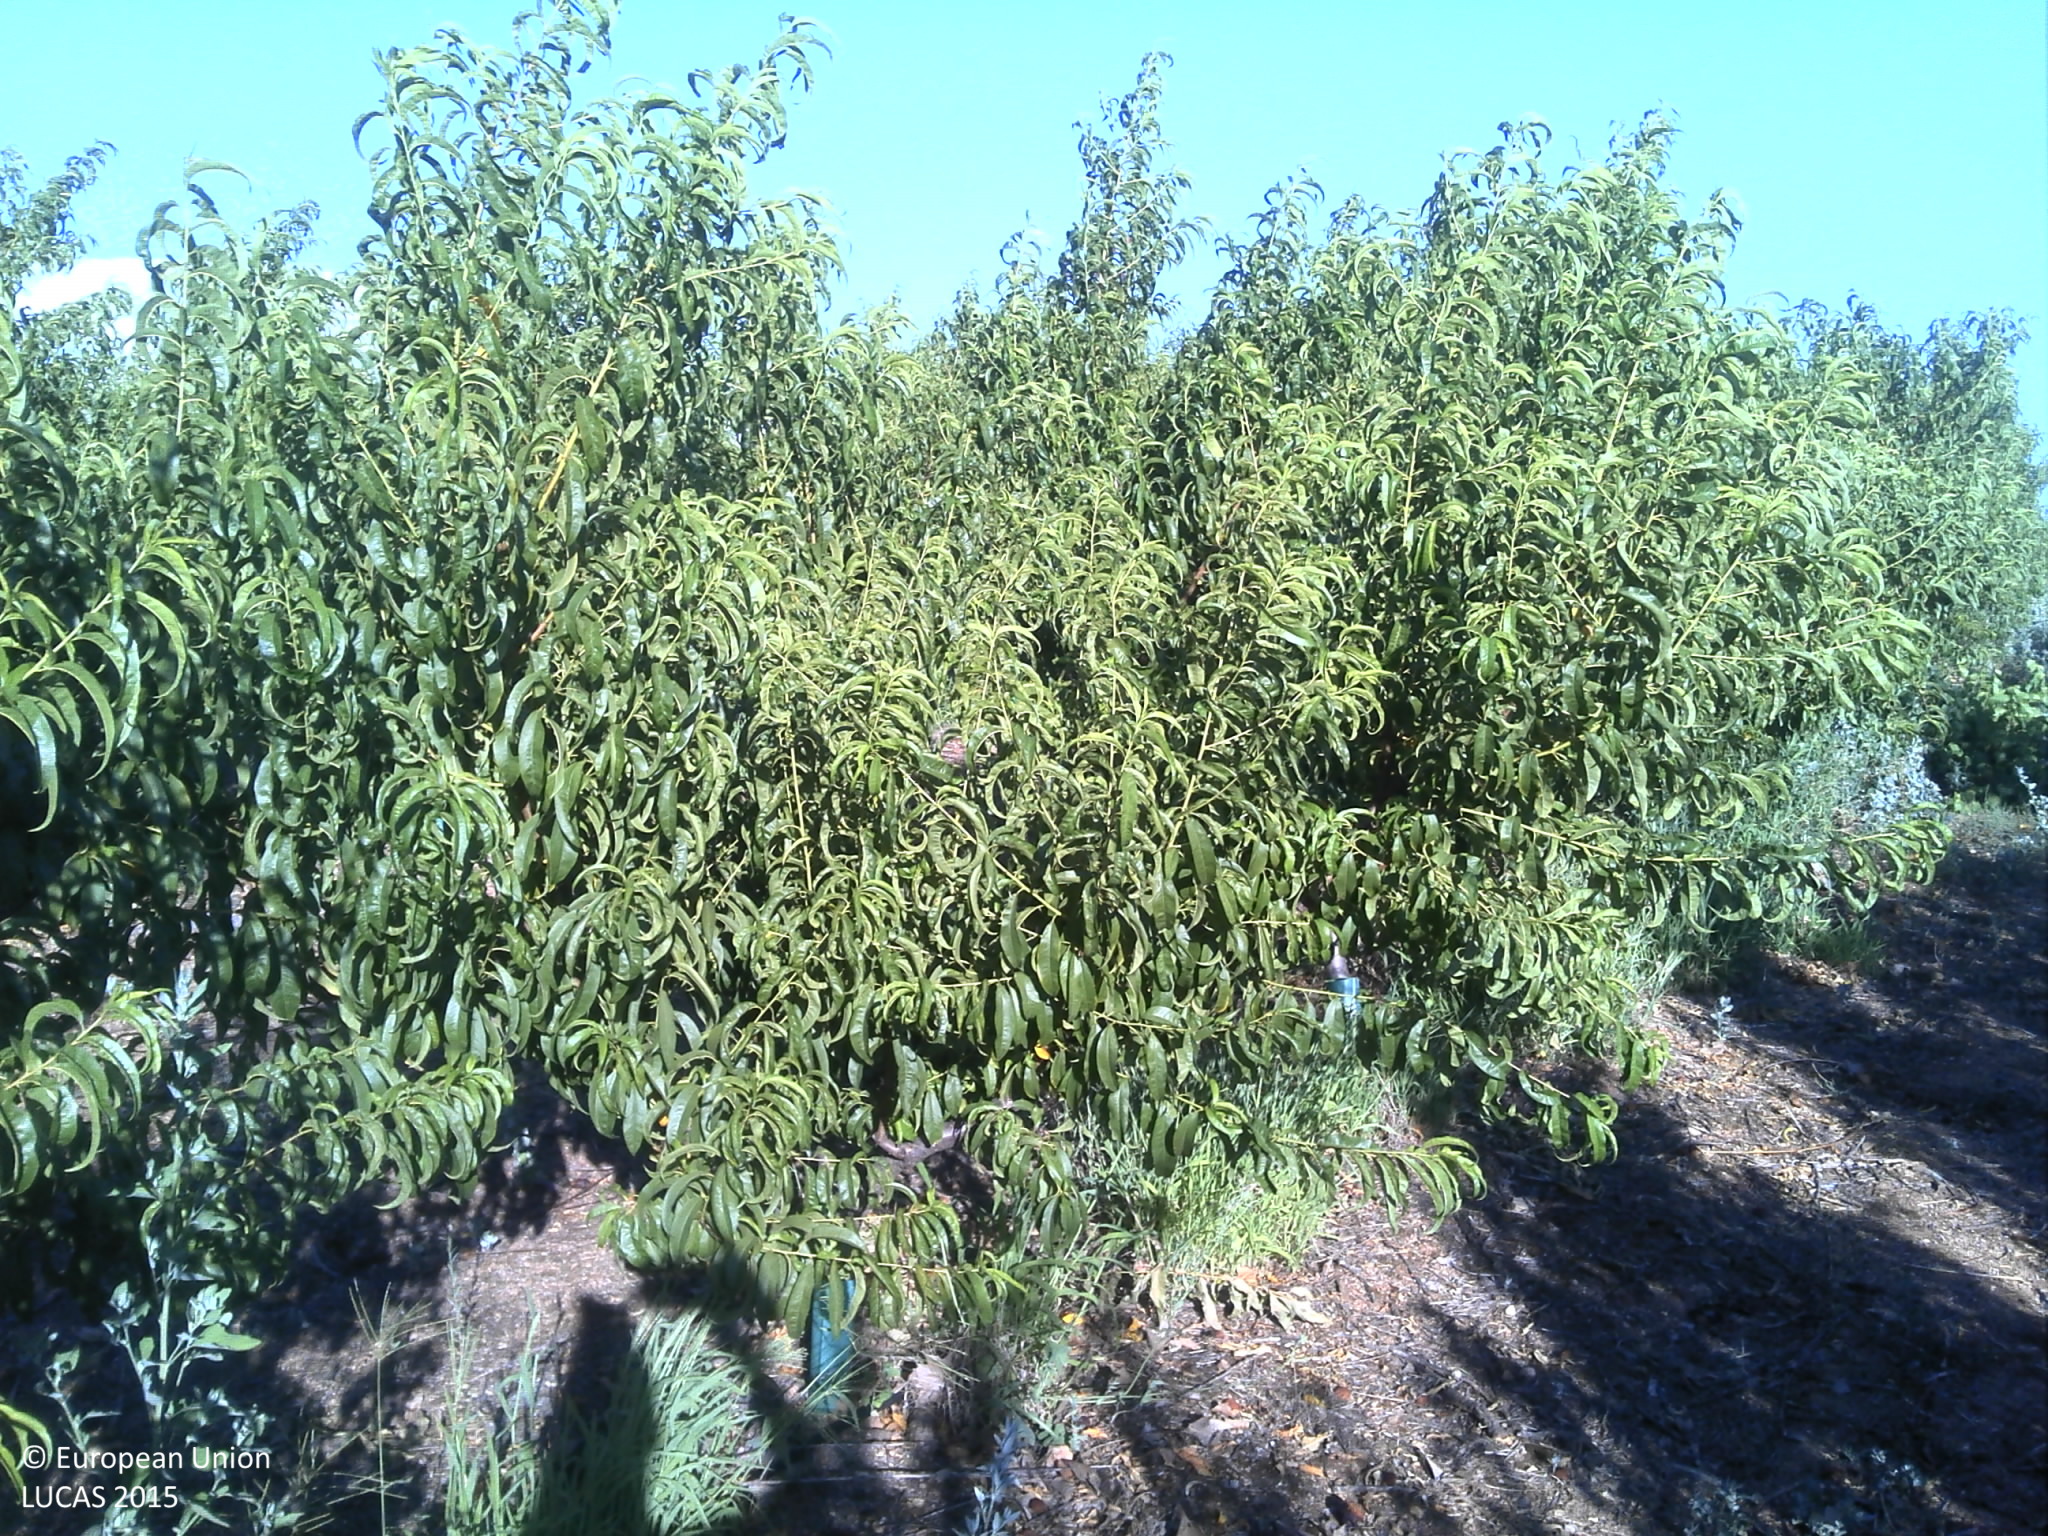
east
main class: Cropland
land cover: Other fruit trees and berries
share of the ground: 50 - 75 %
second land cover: Spontaneously vegetated surfaces
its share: 10 - 25 %
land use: Agriculture (excluding fallow land and kitchen gardens)
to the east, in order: Other fruit trees and berries; Spontaneously vegetated surfaces; Other fruit trees and berries; Electric lines; Other fruit trees and berries; Cherry fruit; Tracks; Grass margins; Rye; Tracks; Other fruit trees and berries; Electric lines; Other fruit trees and berries; Grass margins; Tracks; Grass margins; Other fruit trees and berries
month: July
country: PT
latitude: 40.3415
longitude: -7.3990
